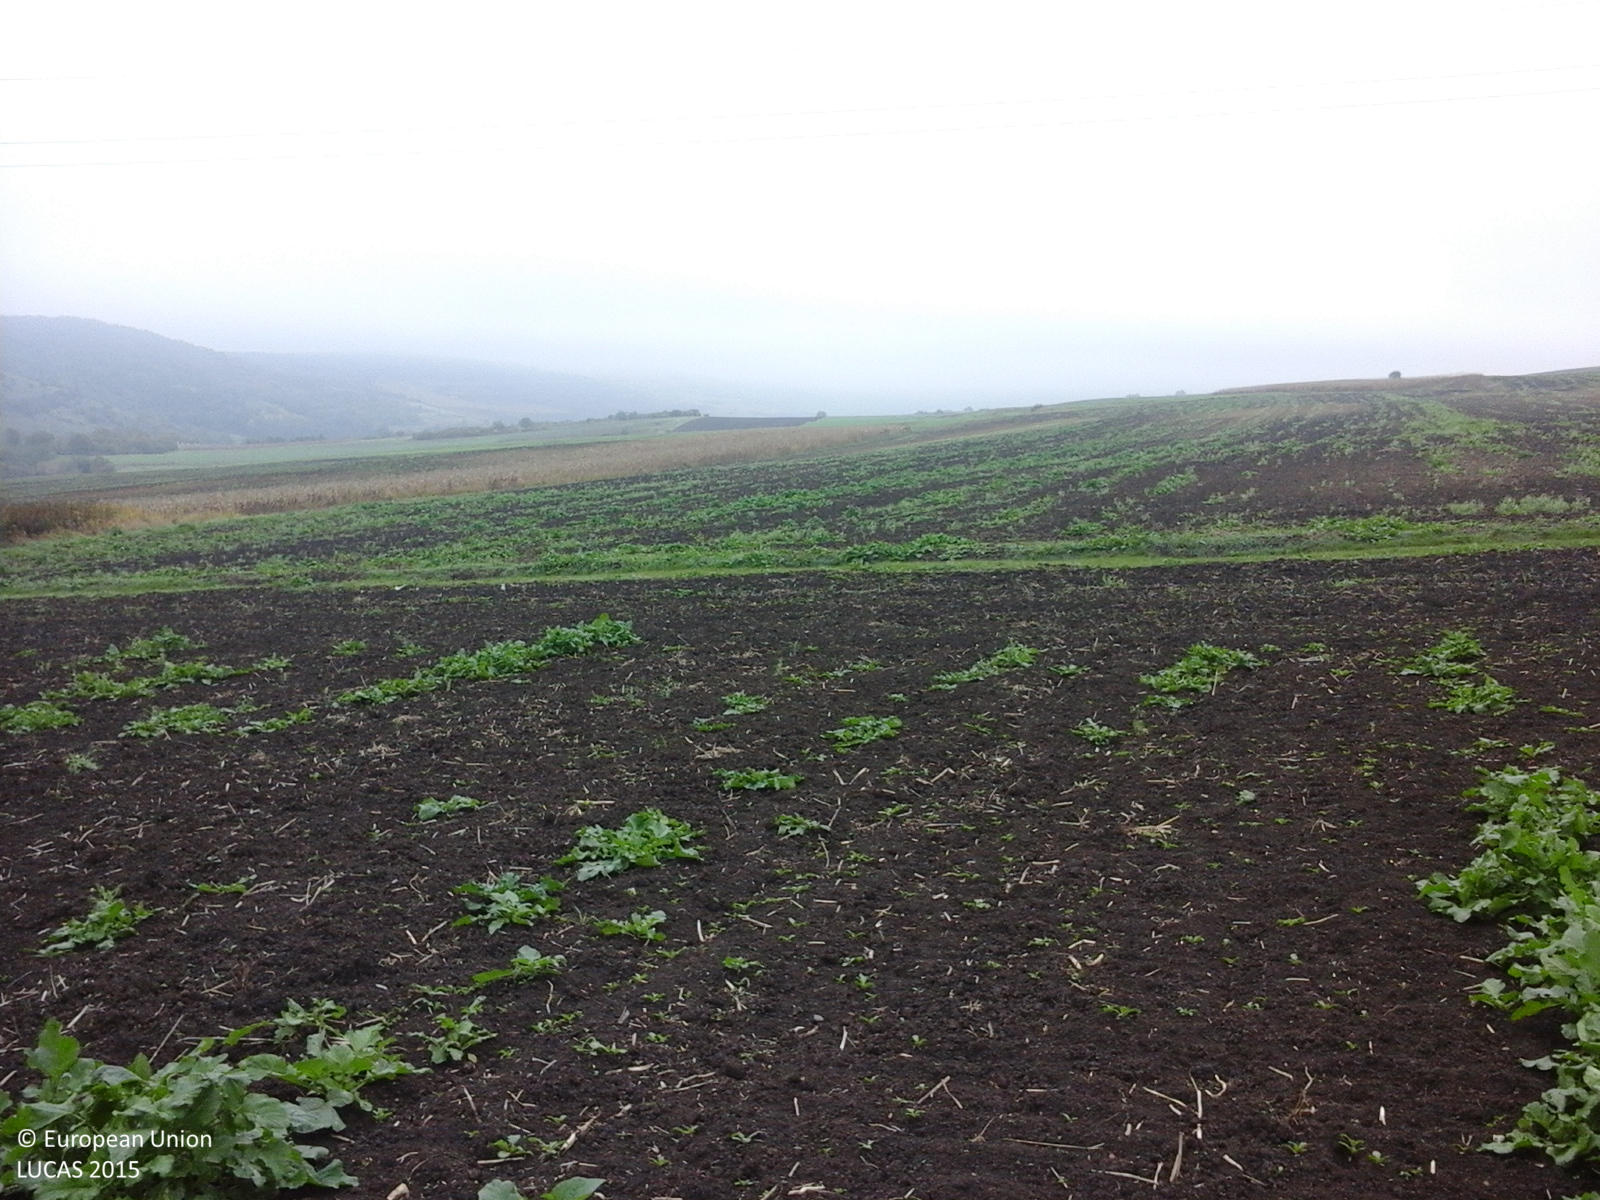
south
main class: Cropland
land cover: Rape and turnip rape
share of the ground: 50 - 75 %
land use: Agriculture (excluding fallow land and kitchen gardens)
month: October
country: RO
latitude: 46.4006
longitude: 24.2186
